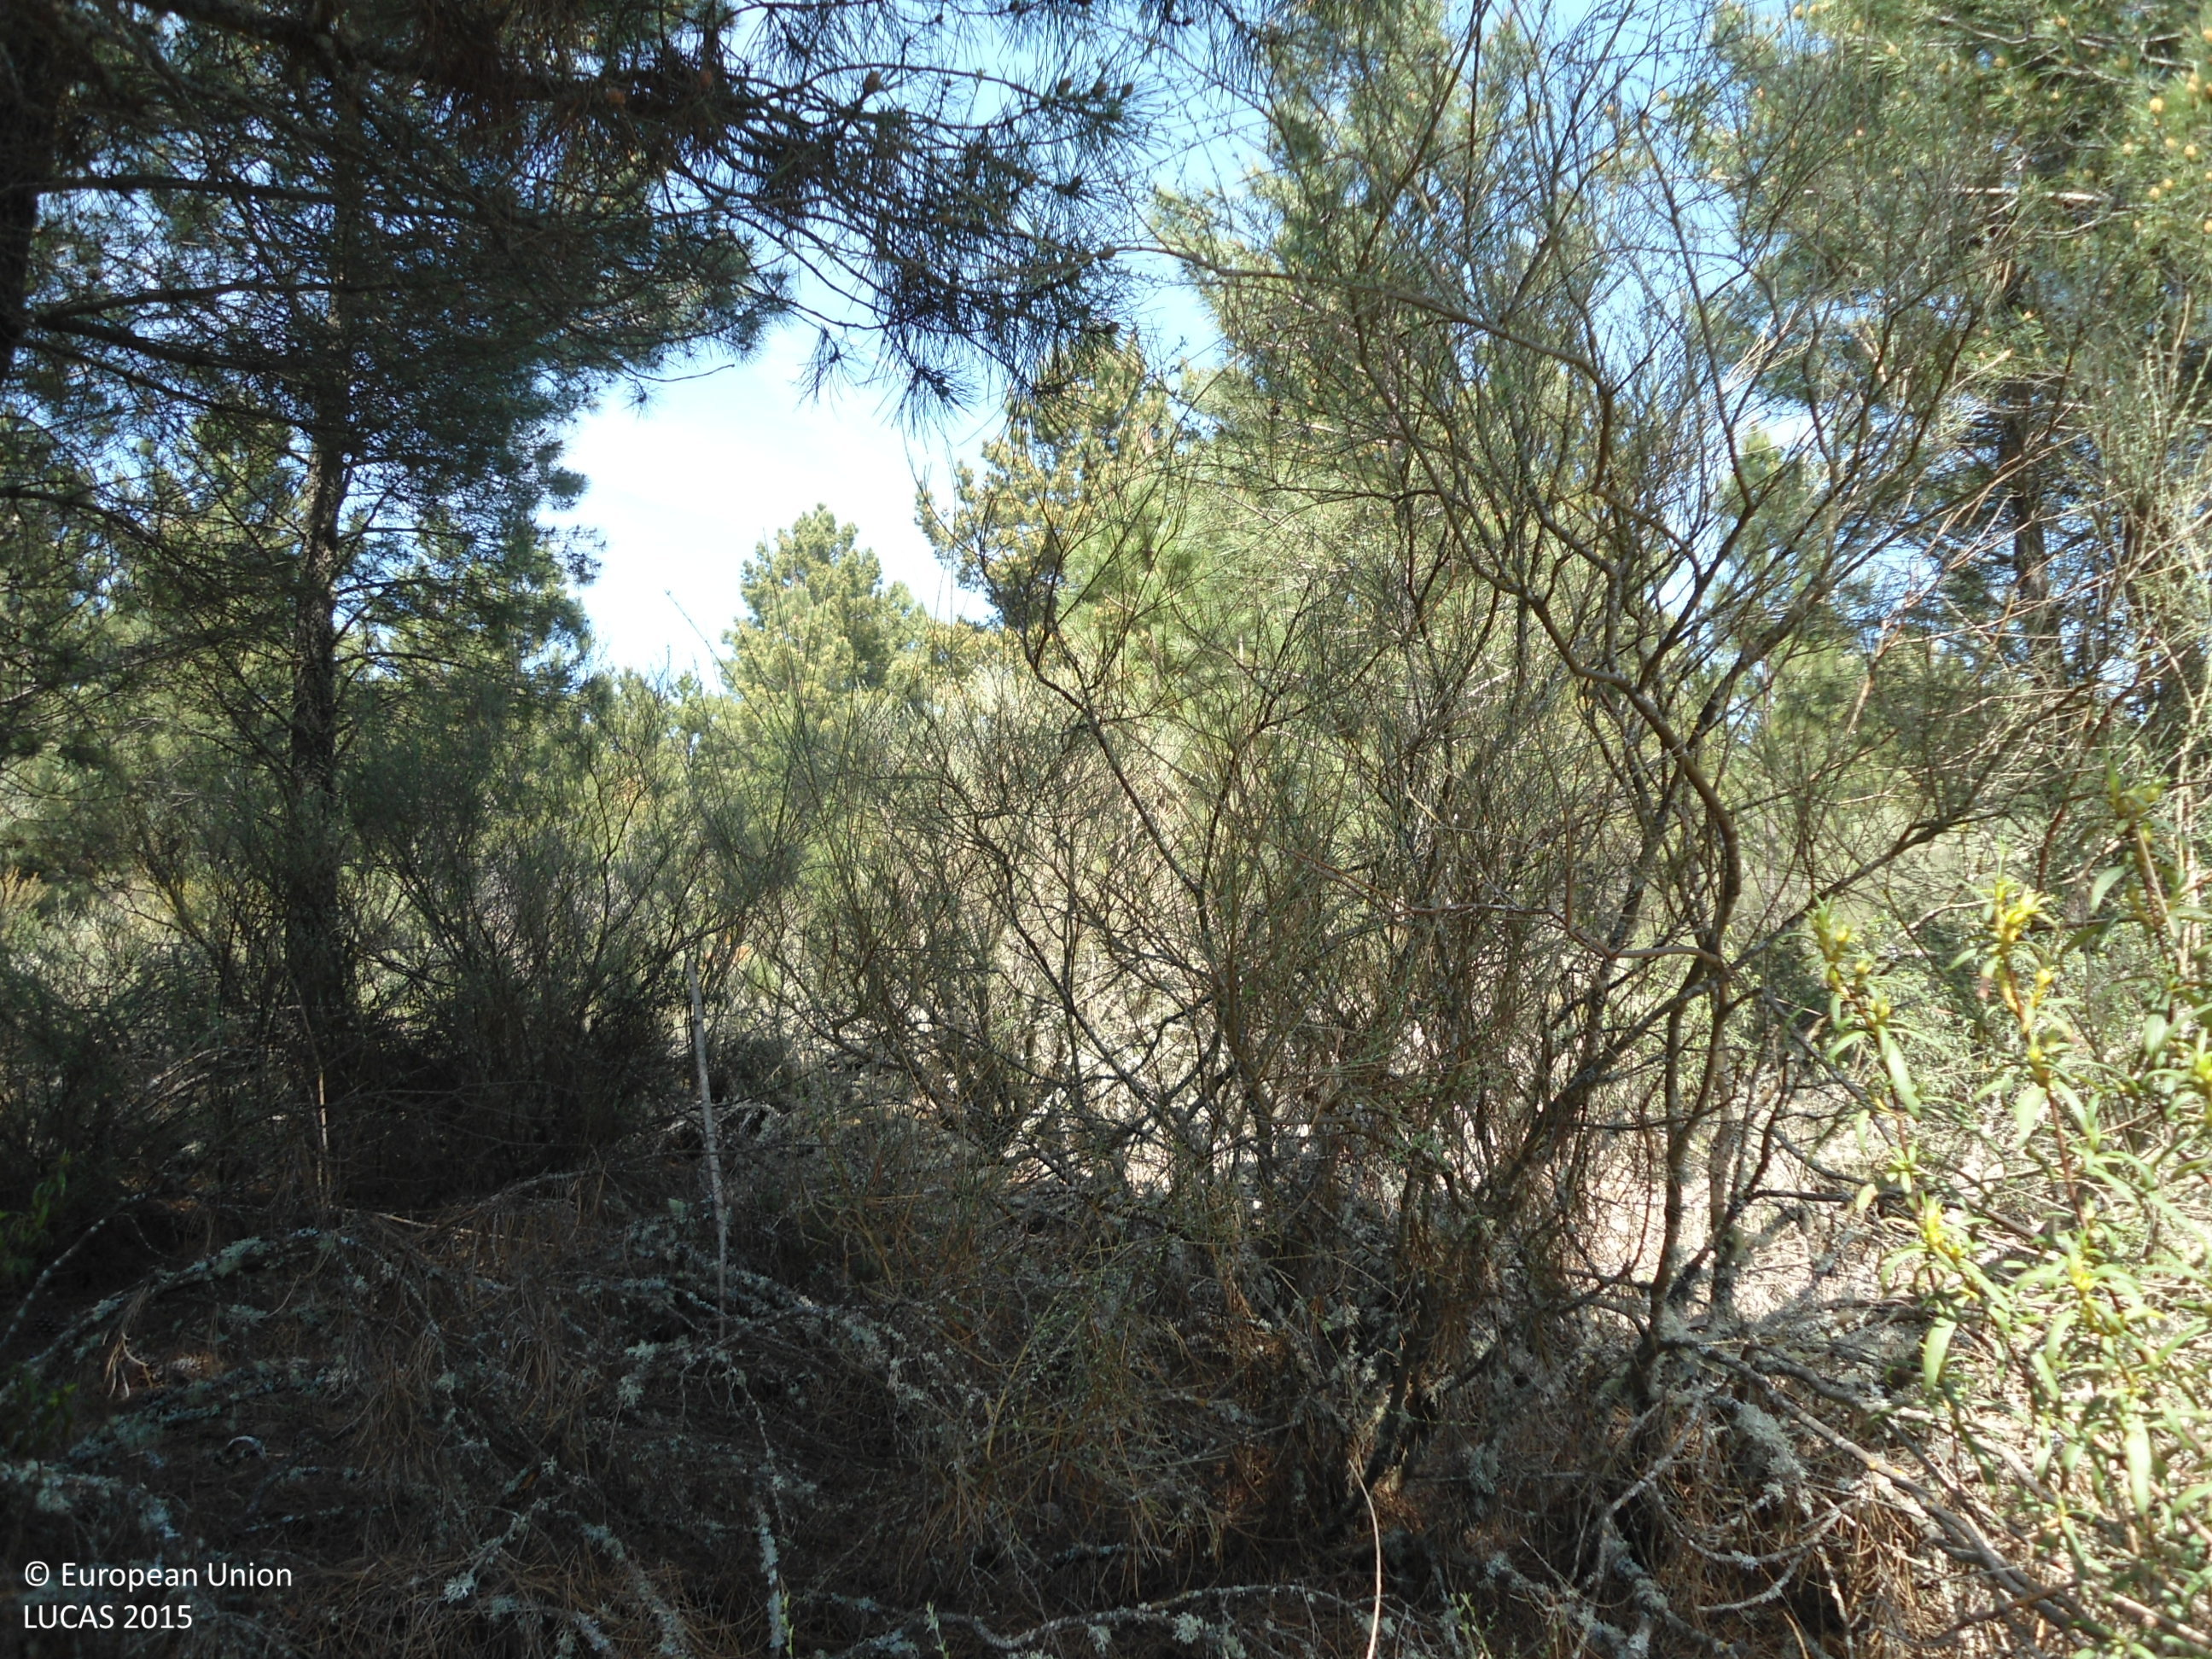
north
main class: Woodland
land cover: Pine dominated coniferous woodland
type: coniferous forest of the mediterranean region
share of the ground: > 75 %
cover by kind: coniferous forest trees 85 %, shrubs 15 %
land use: Forestry
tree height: < 5 m
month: April
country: ES
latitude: 41.8596
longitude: -6.2811
